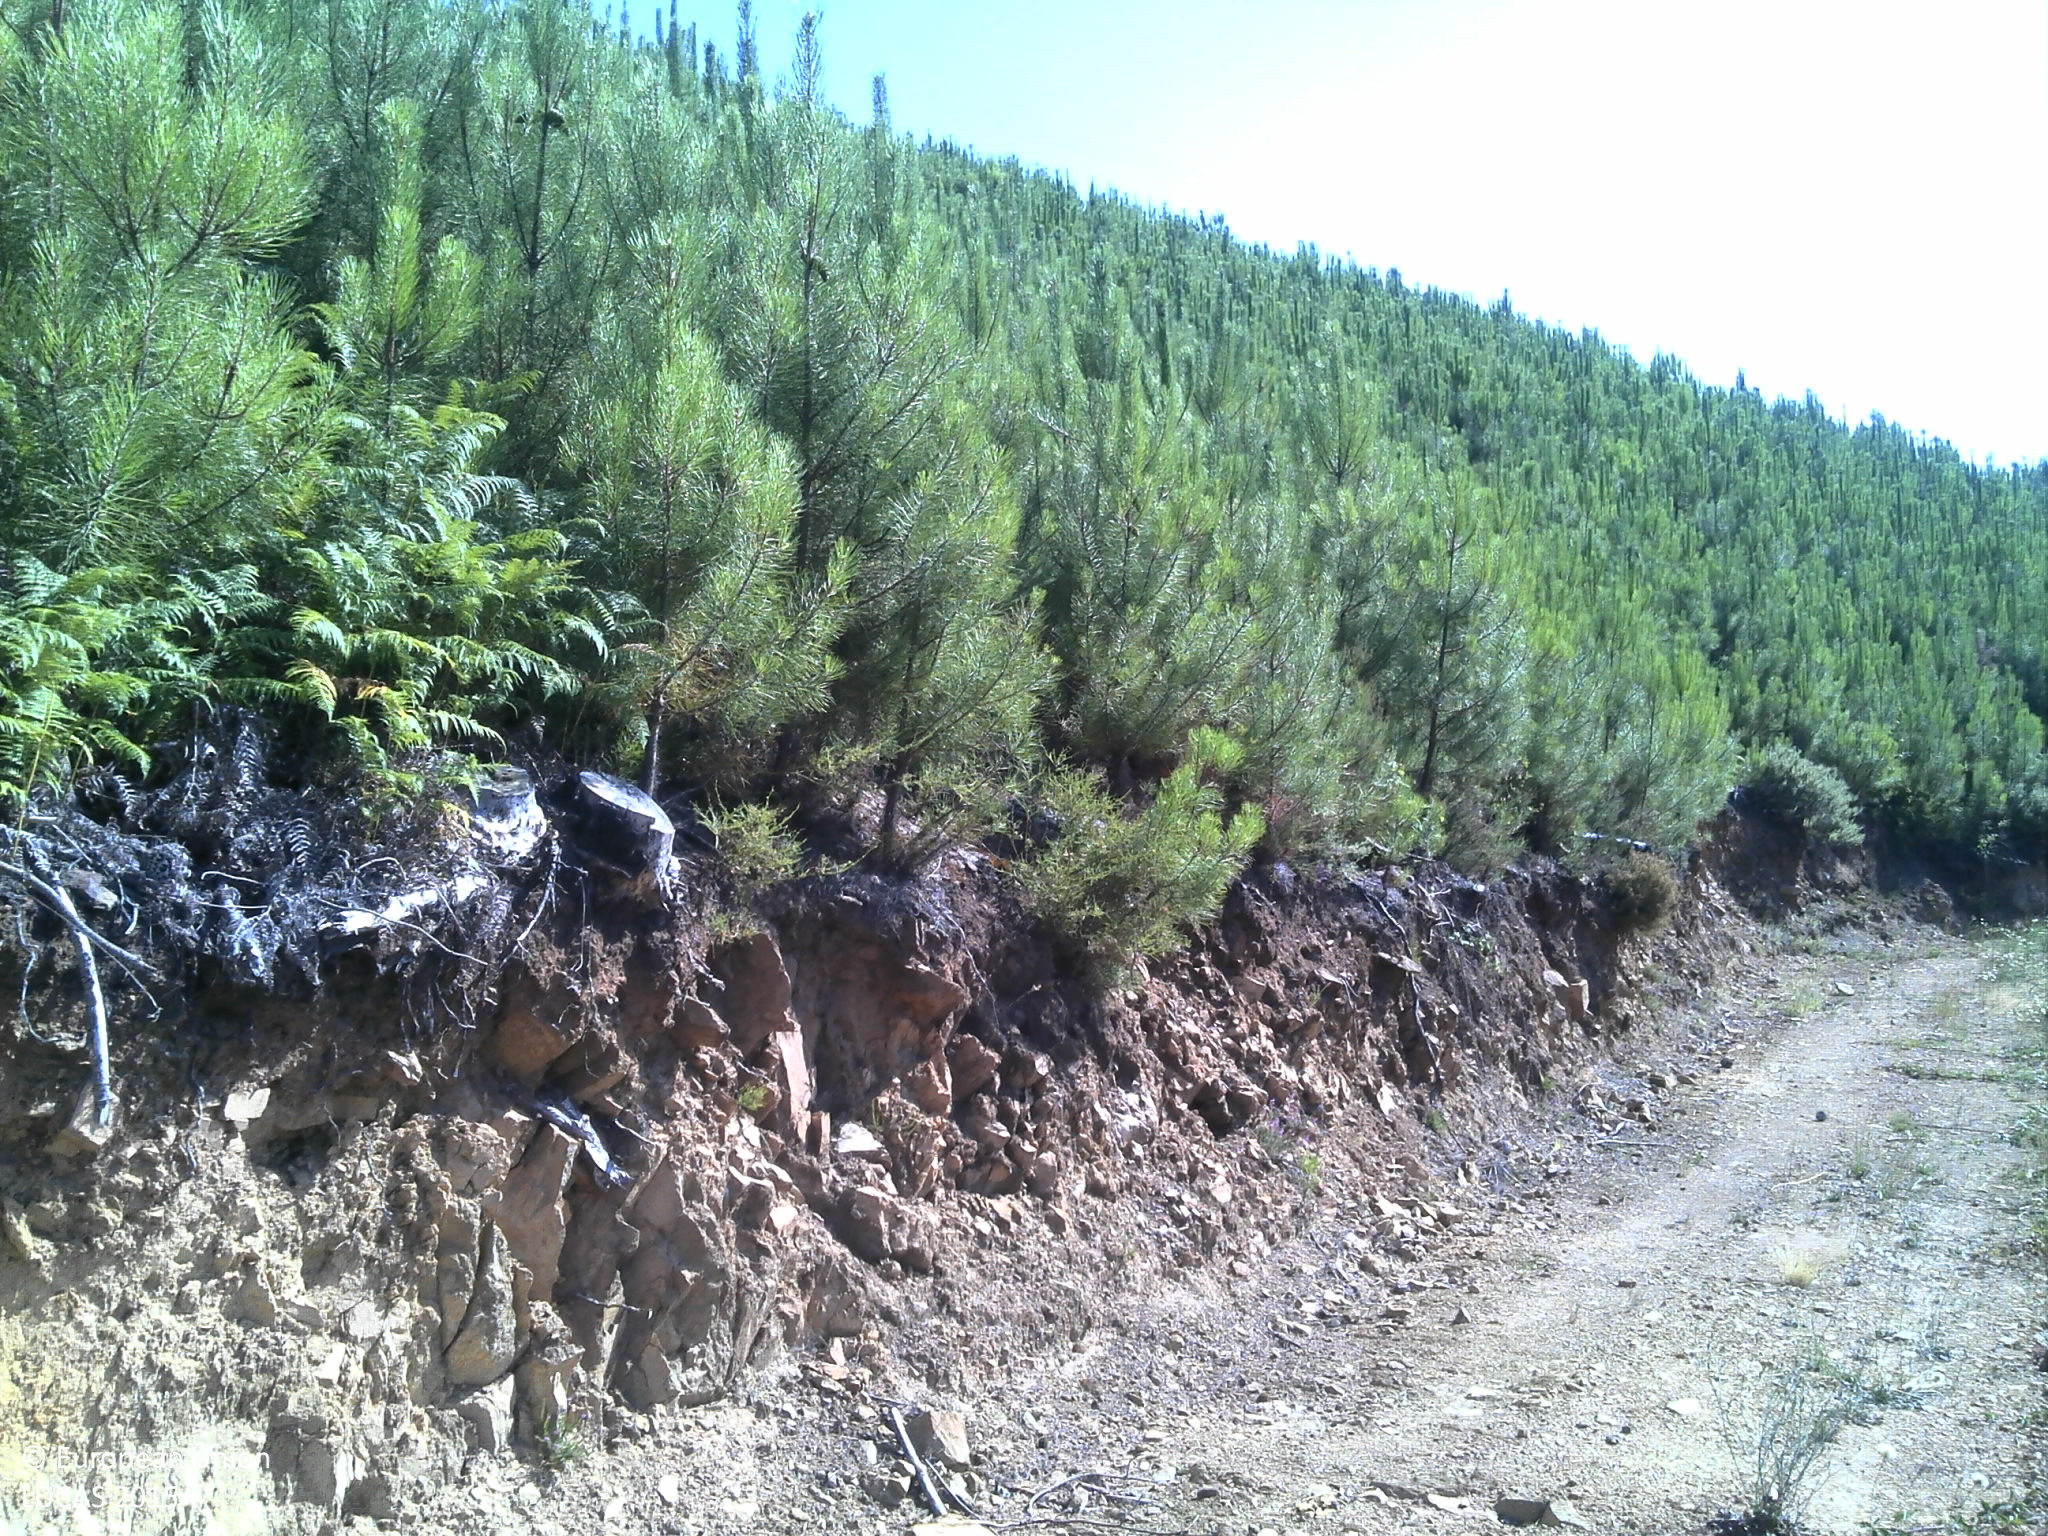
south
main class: Woodland
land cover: Pine dominated coniferous woodland
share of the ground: 50 - 75 %
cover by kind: coniferous forest trees 70 %, shrubs 30 %
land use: Forestry
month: July
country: PT
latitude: 40.3147
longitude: -7.8503
